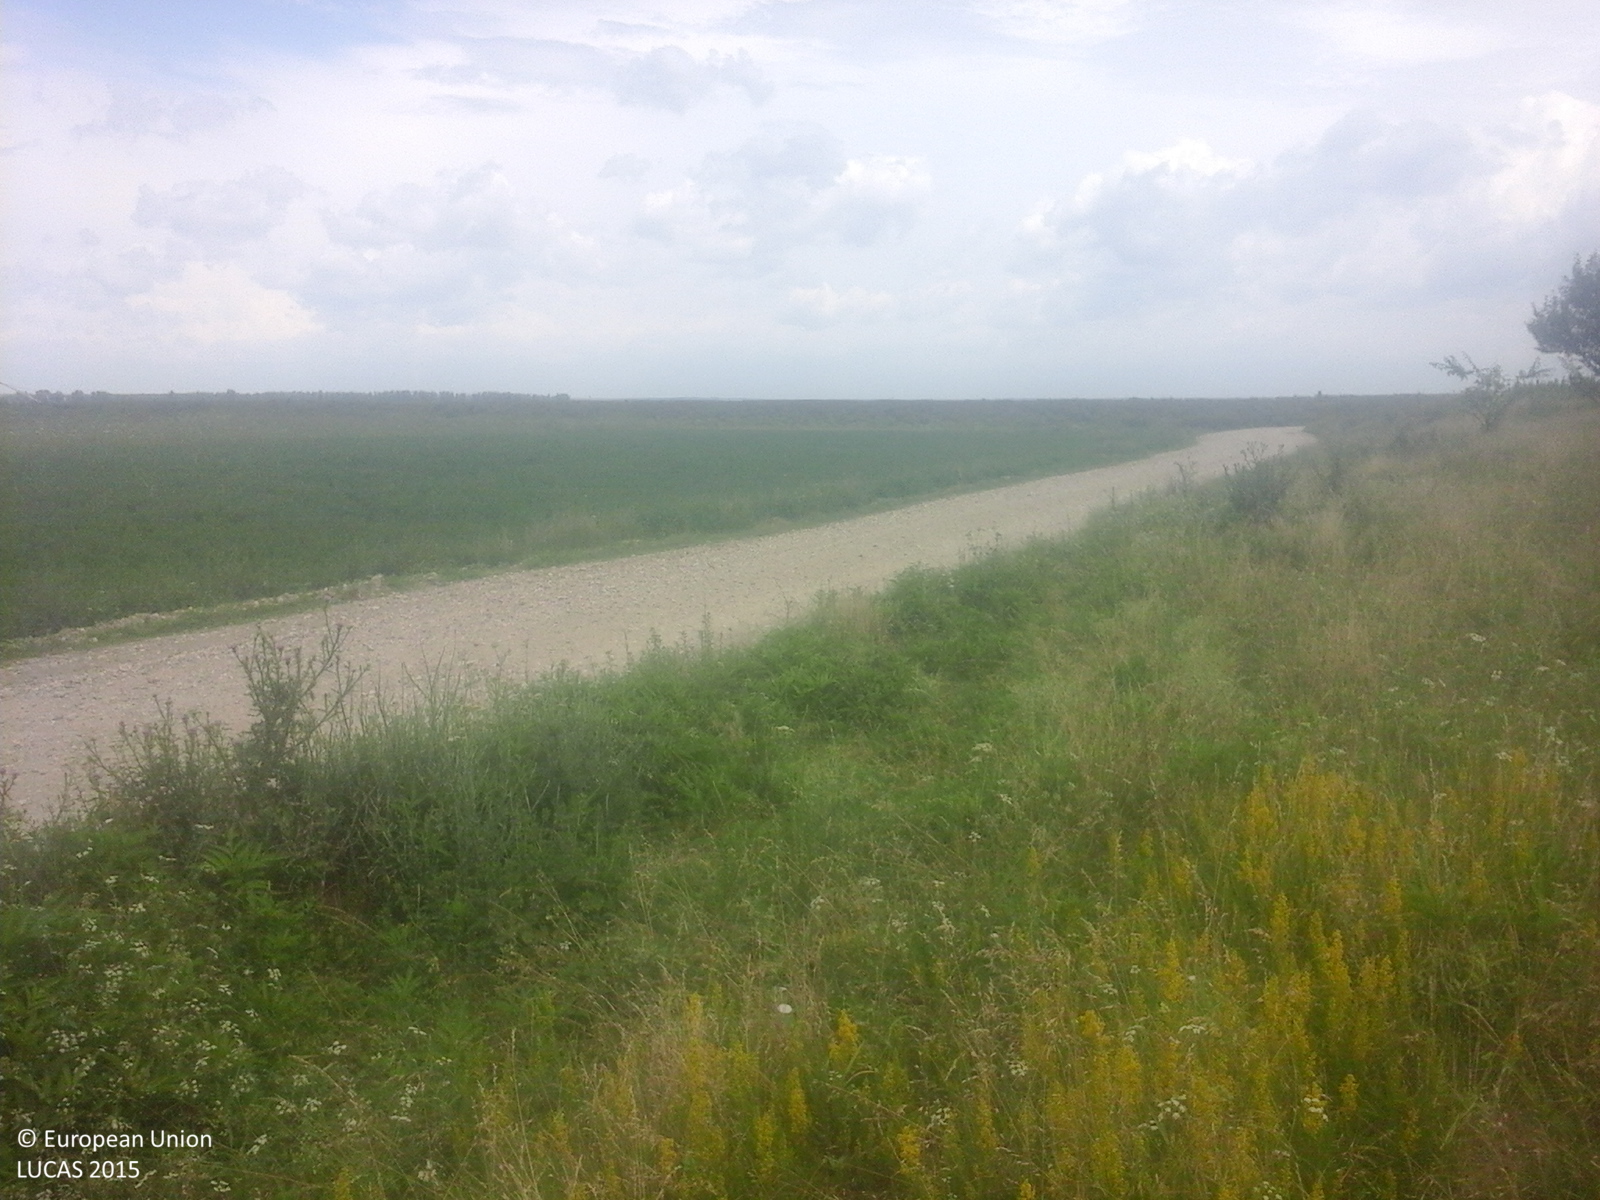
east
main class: Grassland
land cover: Spontaneously vegetated surfaces
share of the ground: > 75 %
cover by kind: herbaceous plants 100 %
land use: Fallow land
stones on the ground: < 10 %
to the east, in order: Spontaneously vegetated surfaces; Paved roads, cycling and walking lanes; Grassland without tree/shrub cover
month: July
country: RO
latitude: 43.7884
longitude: 24.7198
